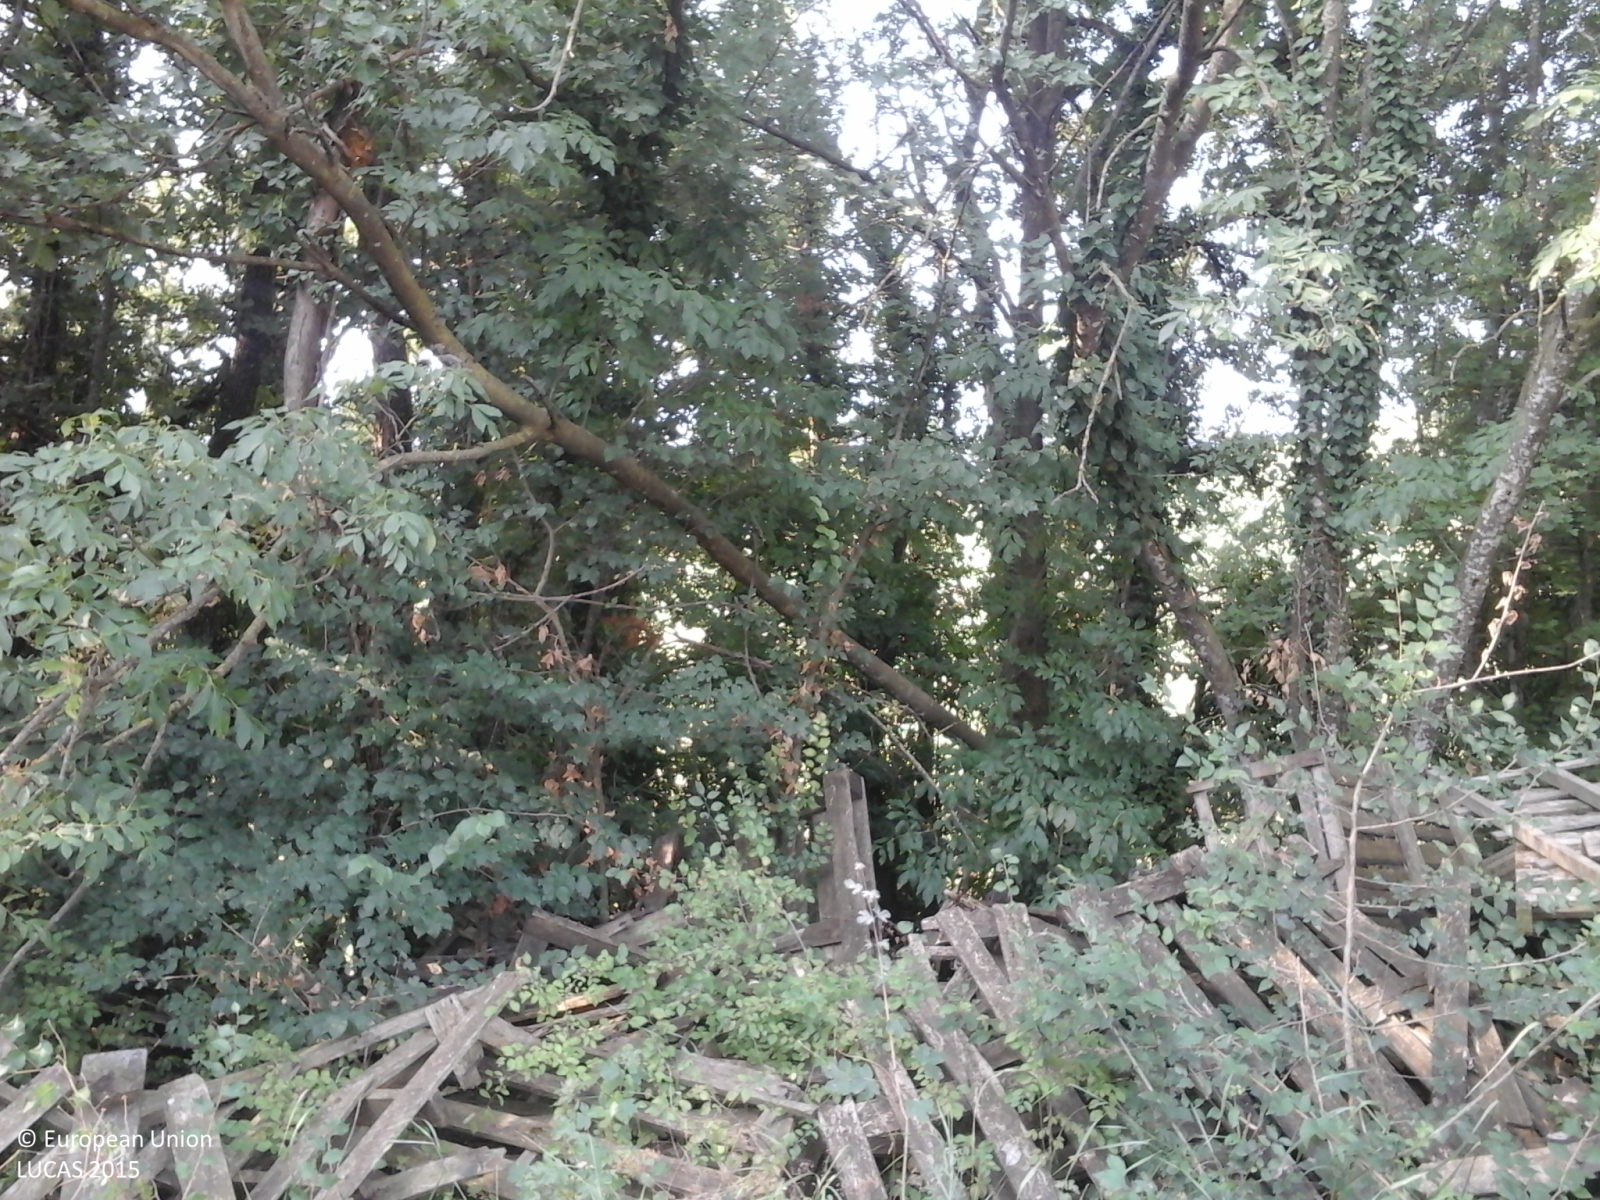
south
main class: Cropland
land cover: Maize
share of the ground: > 75 %
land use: Agriculture (excluding fallow land and kitchen gardens)
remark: Harvested field
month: July
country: IT
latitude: 44.3648
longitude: 10.8889
